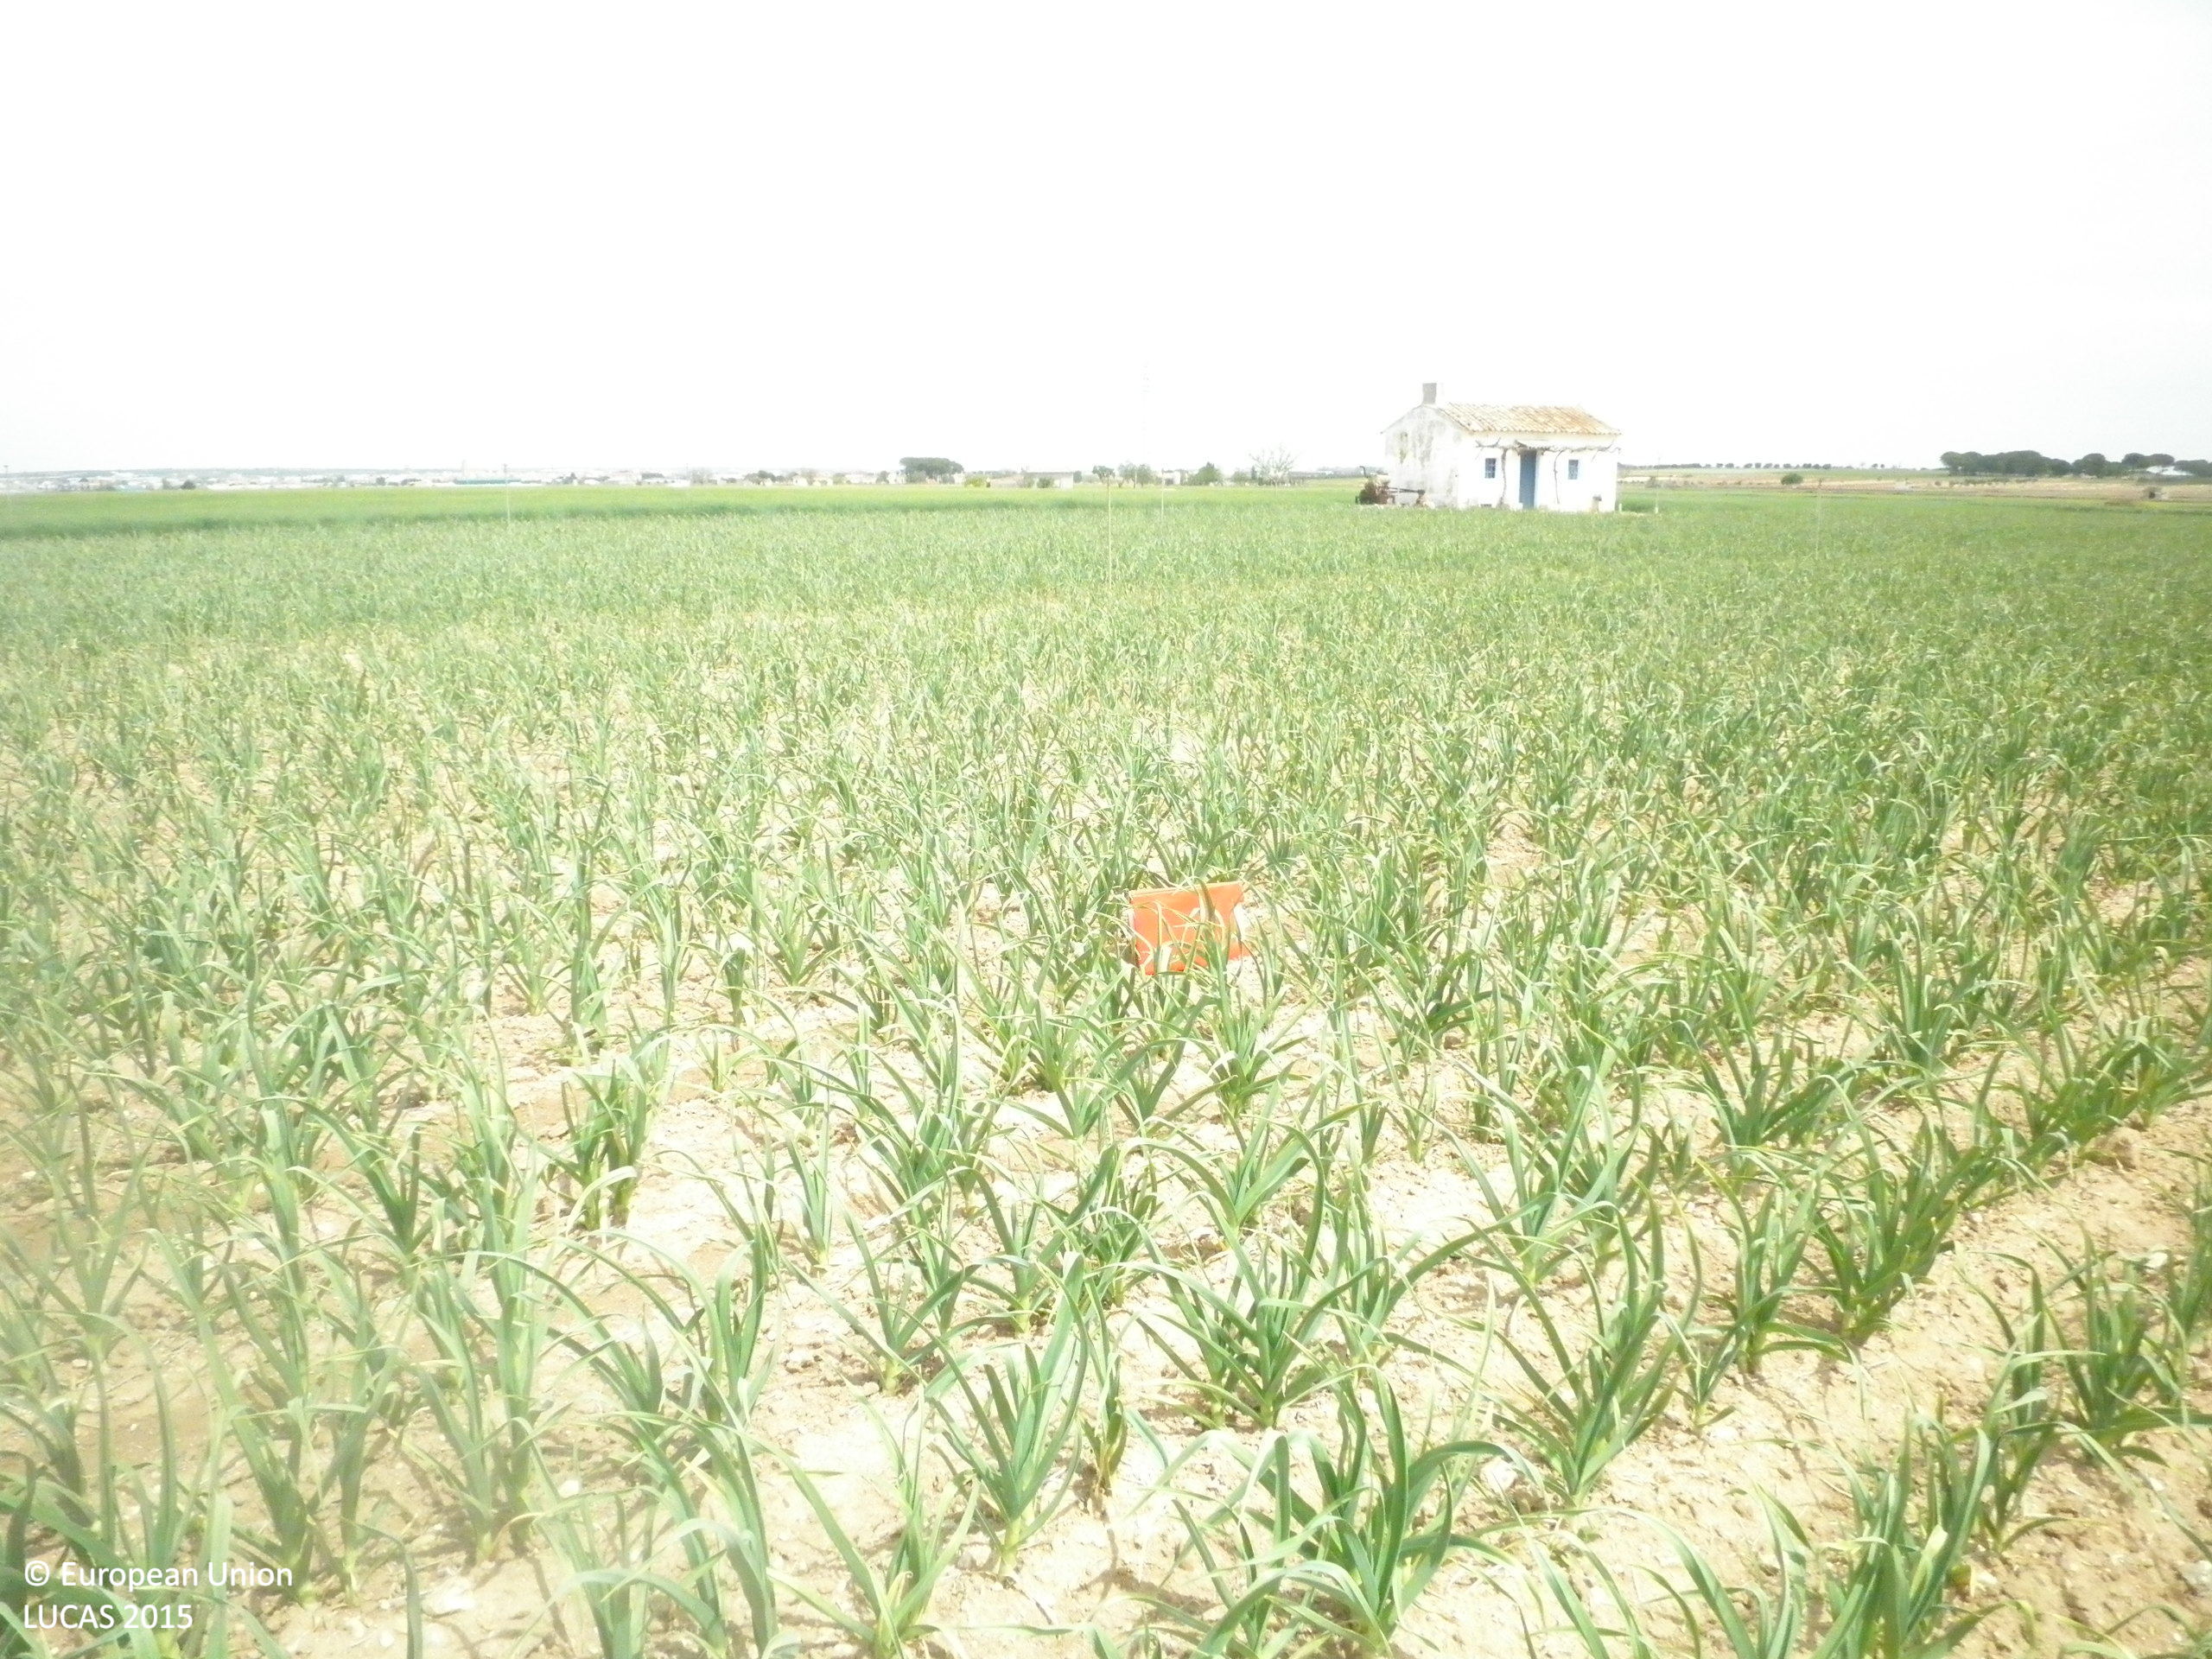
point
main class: Cropland
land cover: Other root crops
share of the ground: 10 - 25 %
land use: Agriculture (excluding fallow land and kitchen gardens)
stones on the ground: < 10 %
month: April
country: ES
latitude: 39.4219
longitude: -2.6859
